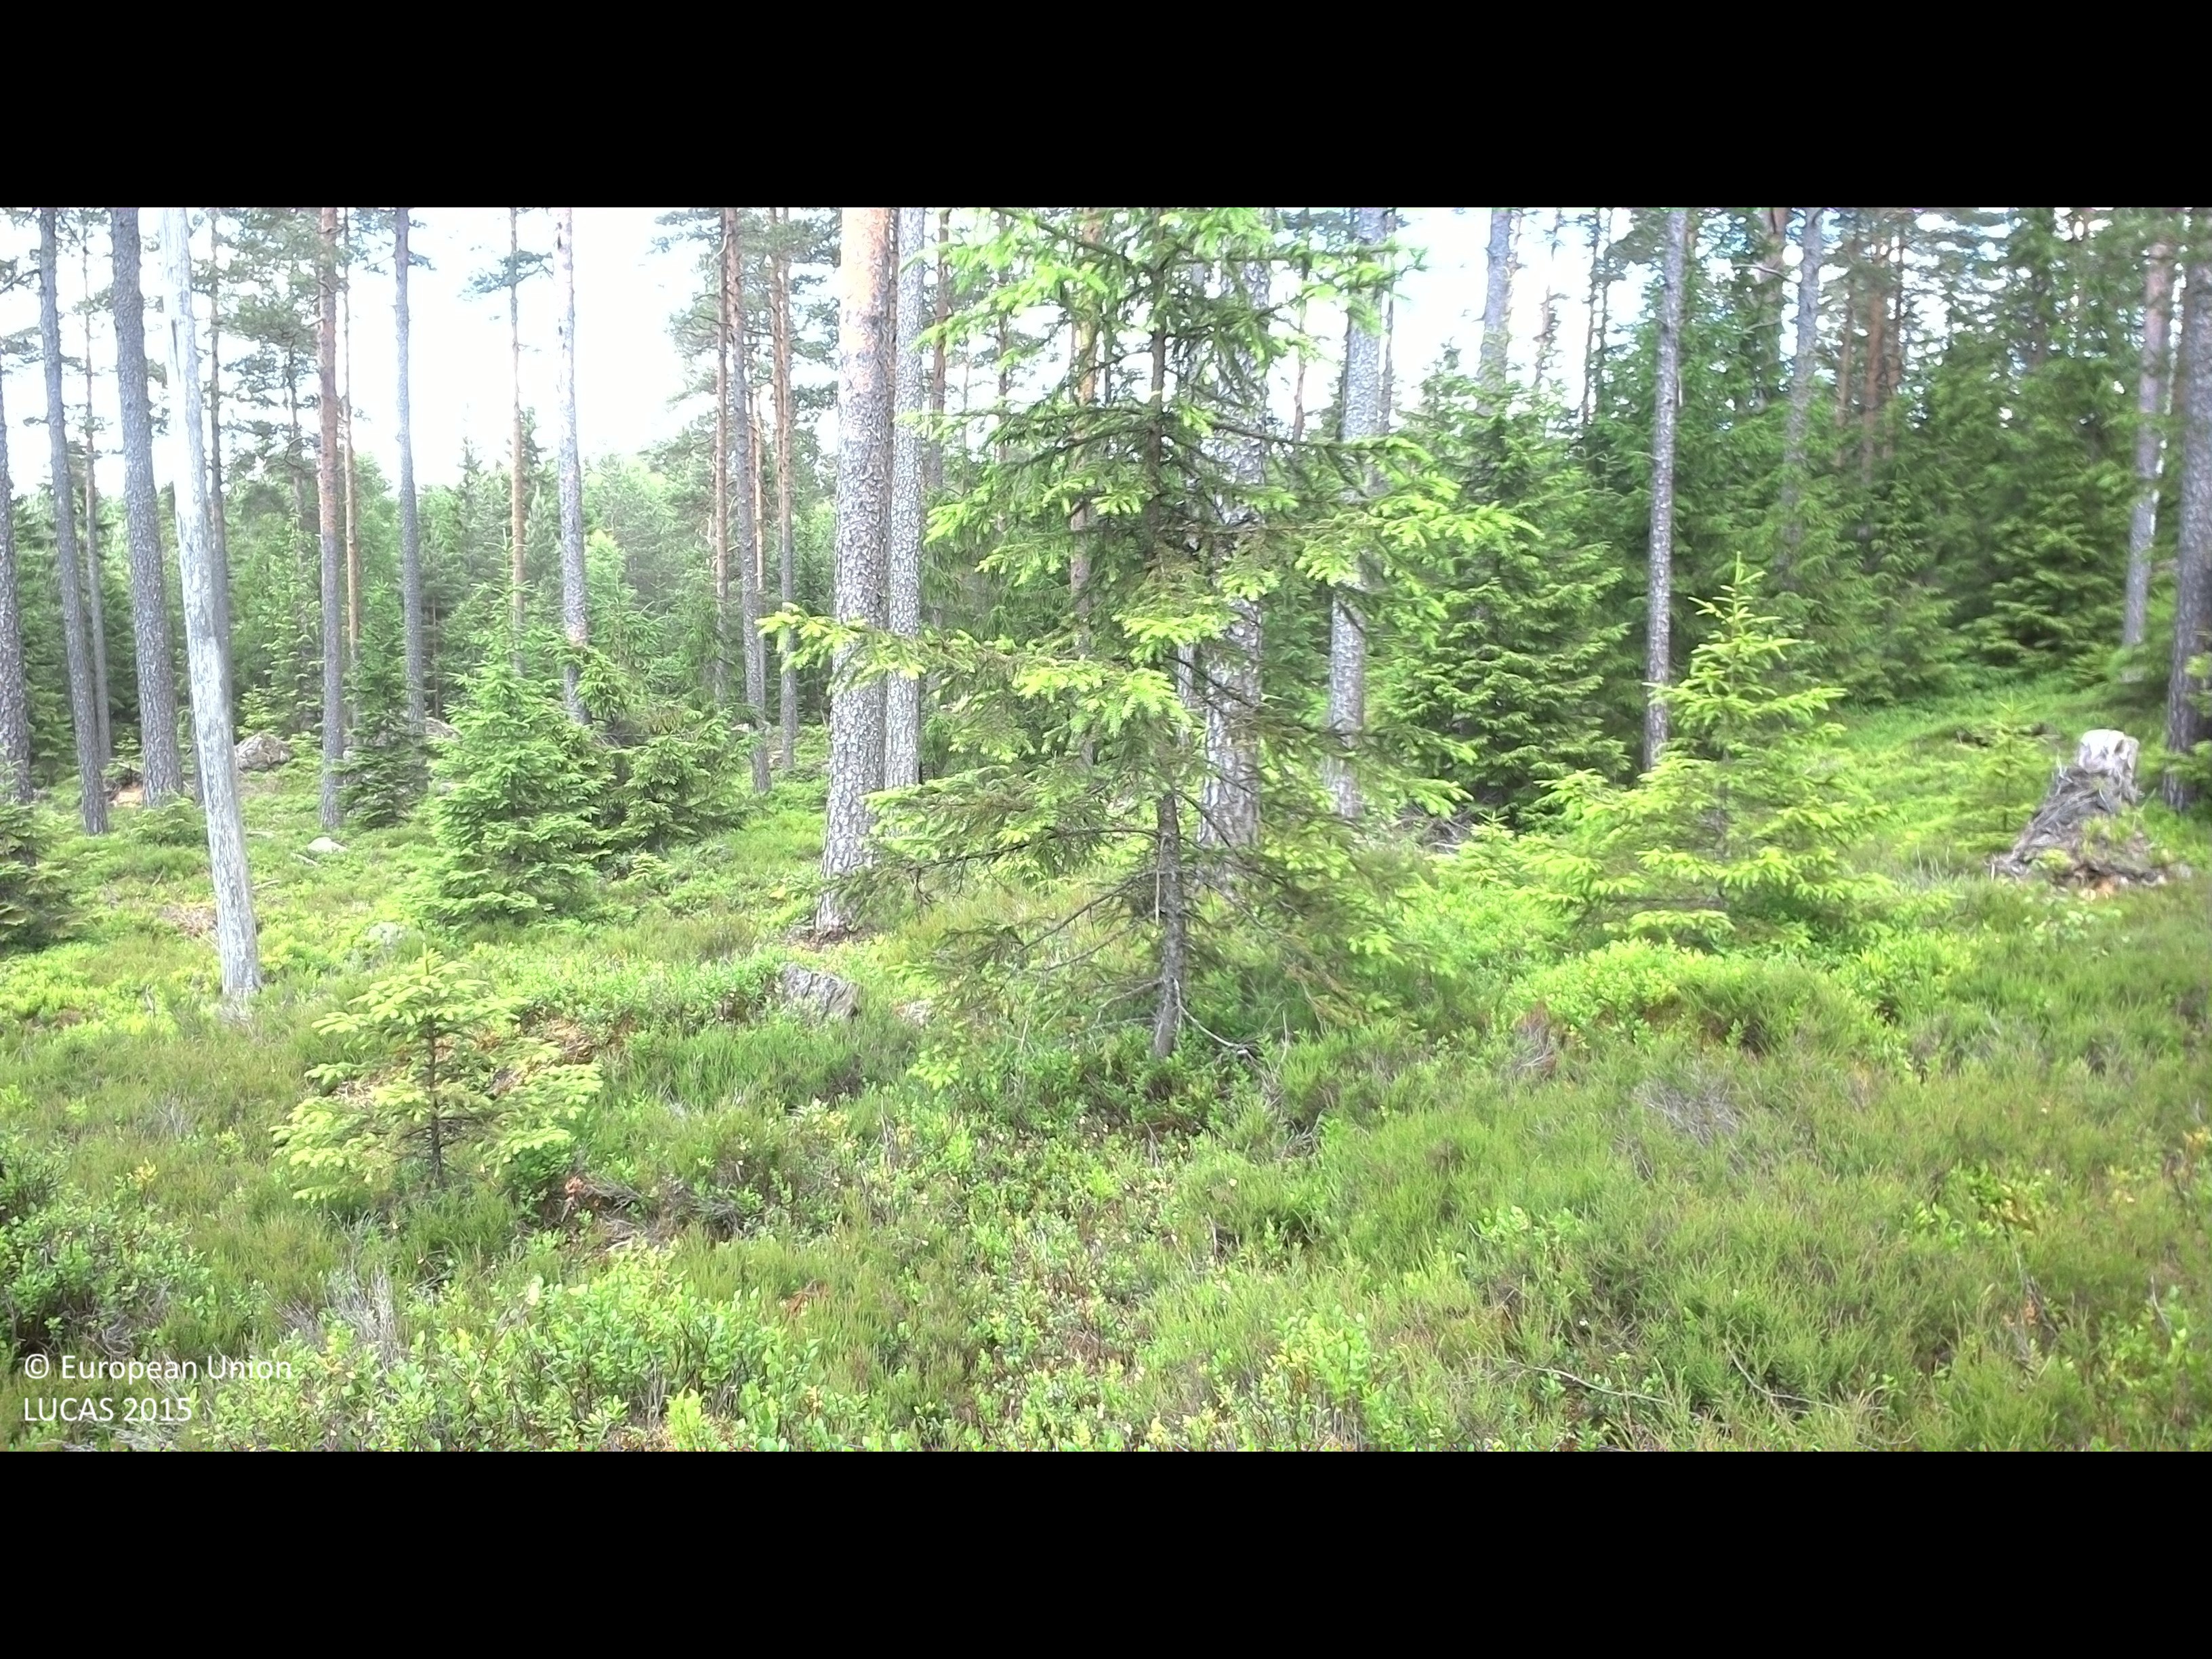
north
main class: Woodland
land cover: Pine dominated coniferous woodland
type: boreal forest
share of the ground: 50 - 75 %
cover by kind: coniferous forest trees 50 %, shrubs 35 %, lichens and mosses 15 %
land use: Forestry
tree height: > 5 m
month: July
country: SE
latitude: 56.4055
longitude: 15.2329
